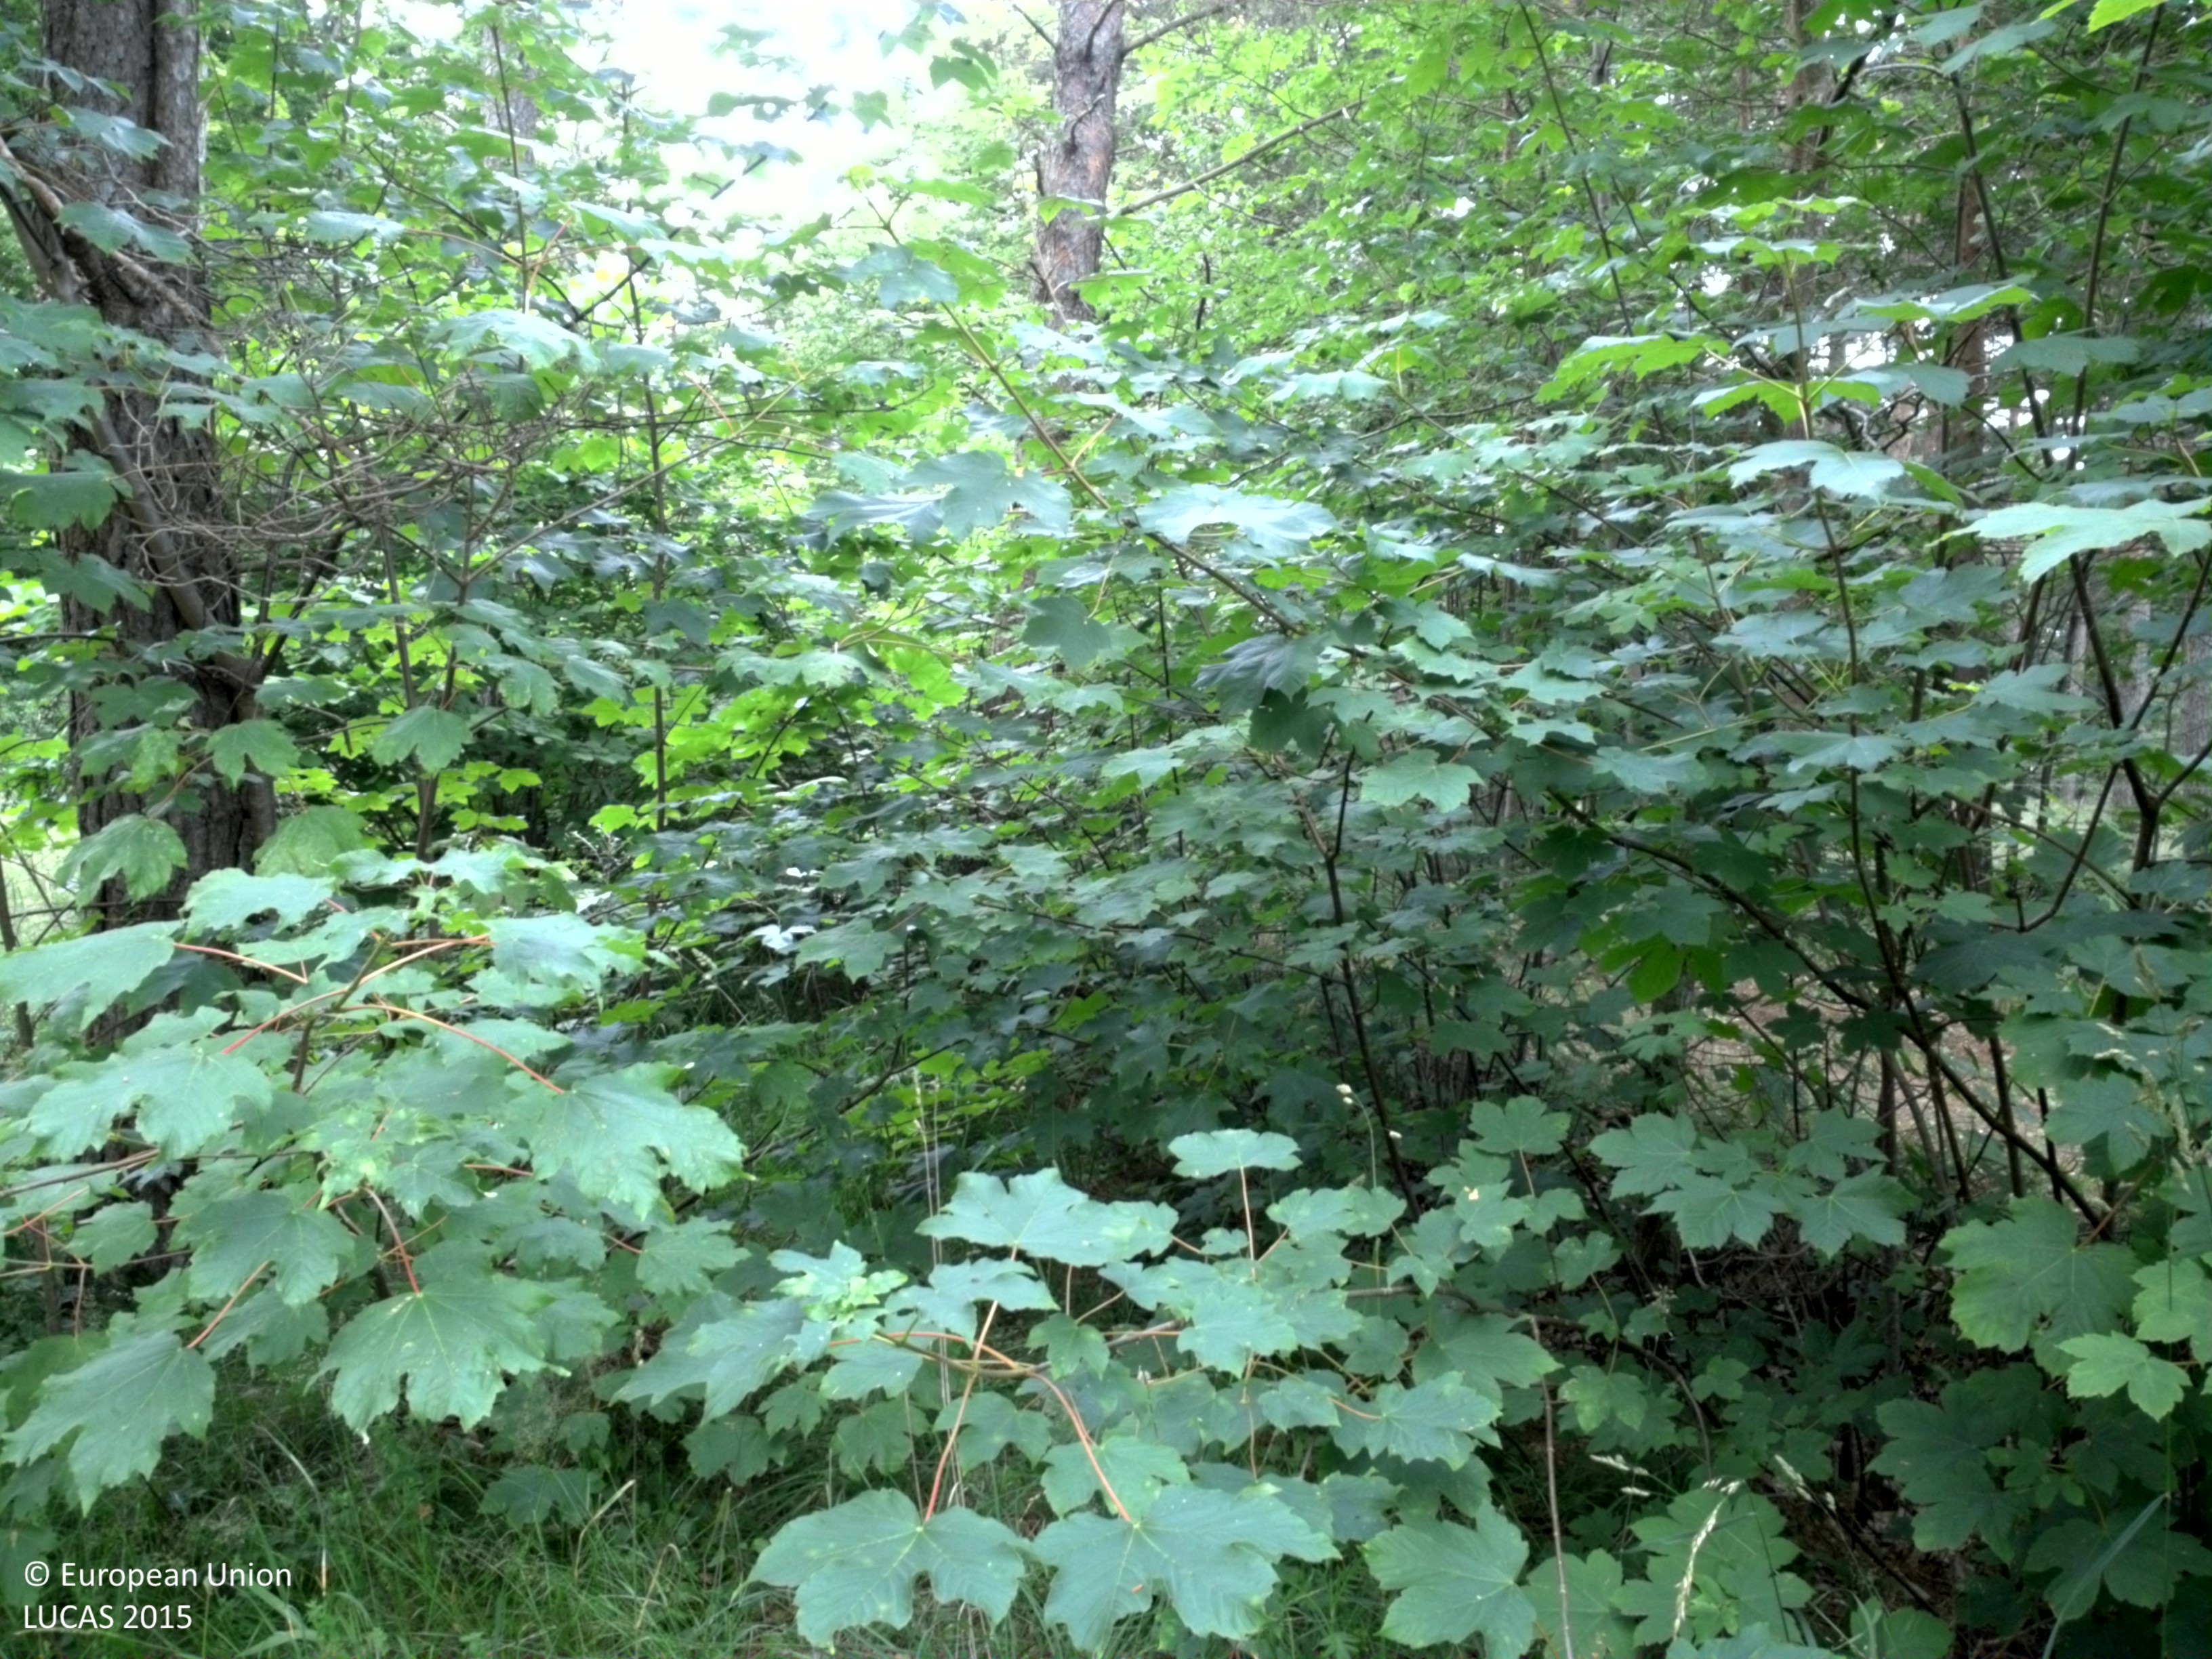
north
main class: Woodland
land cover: Pine dominated mixed woodland
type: hemiboreal forest and nemoral coniferous forest and mixed broadleaved-coniferous forest
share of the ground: > 75 %
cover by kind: coniferous forest trees 55 %, broadleaved forest trees 20 %, herbaceous plants 15 %, shrubs 10 %
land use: Forestry
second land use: Amenities, museums, leisure
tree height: > 5 m
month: July
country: SE
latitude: 57.4440
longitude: 18.4896
